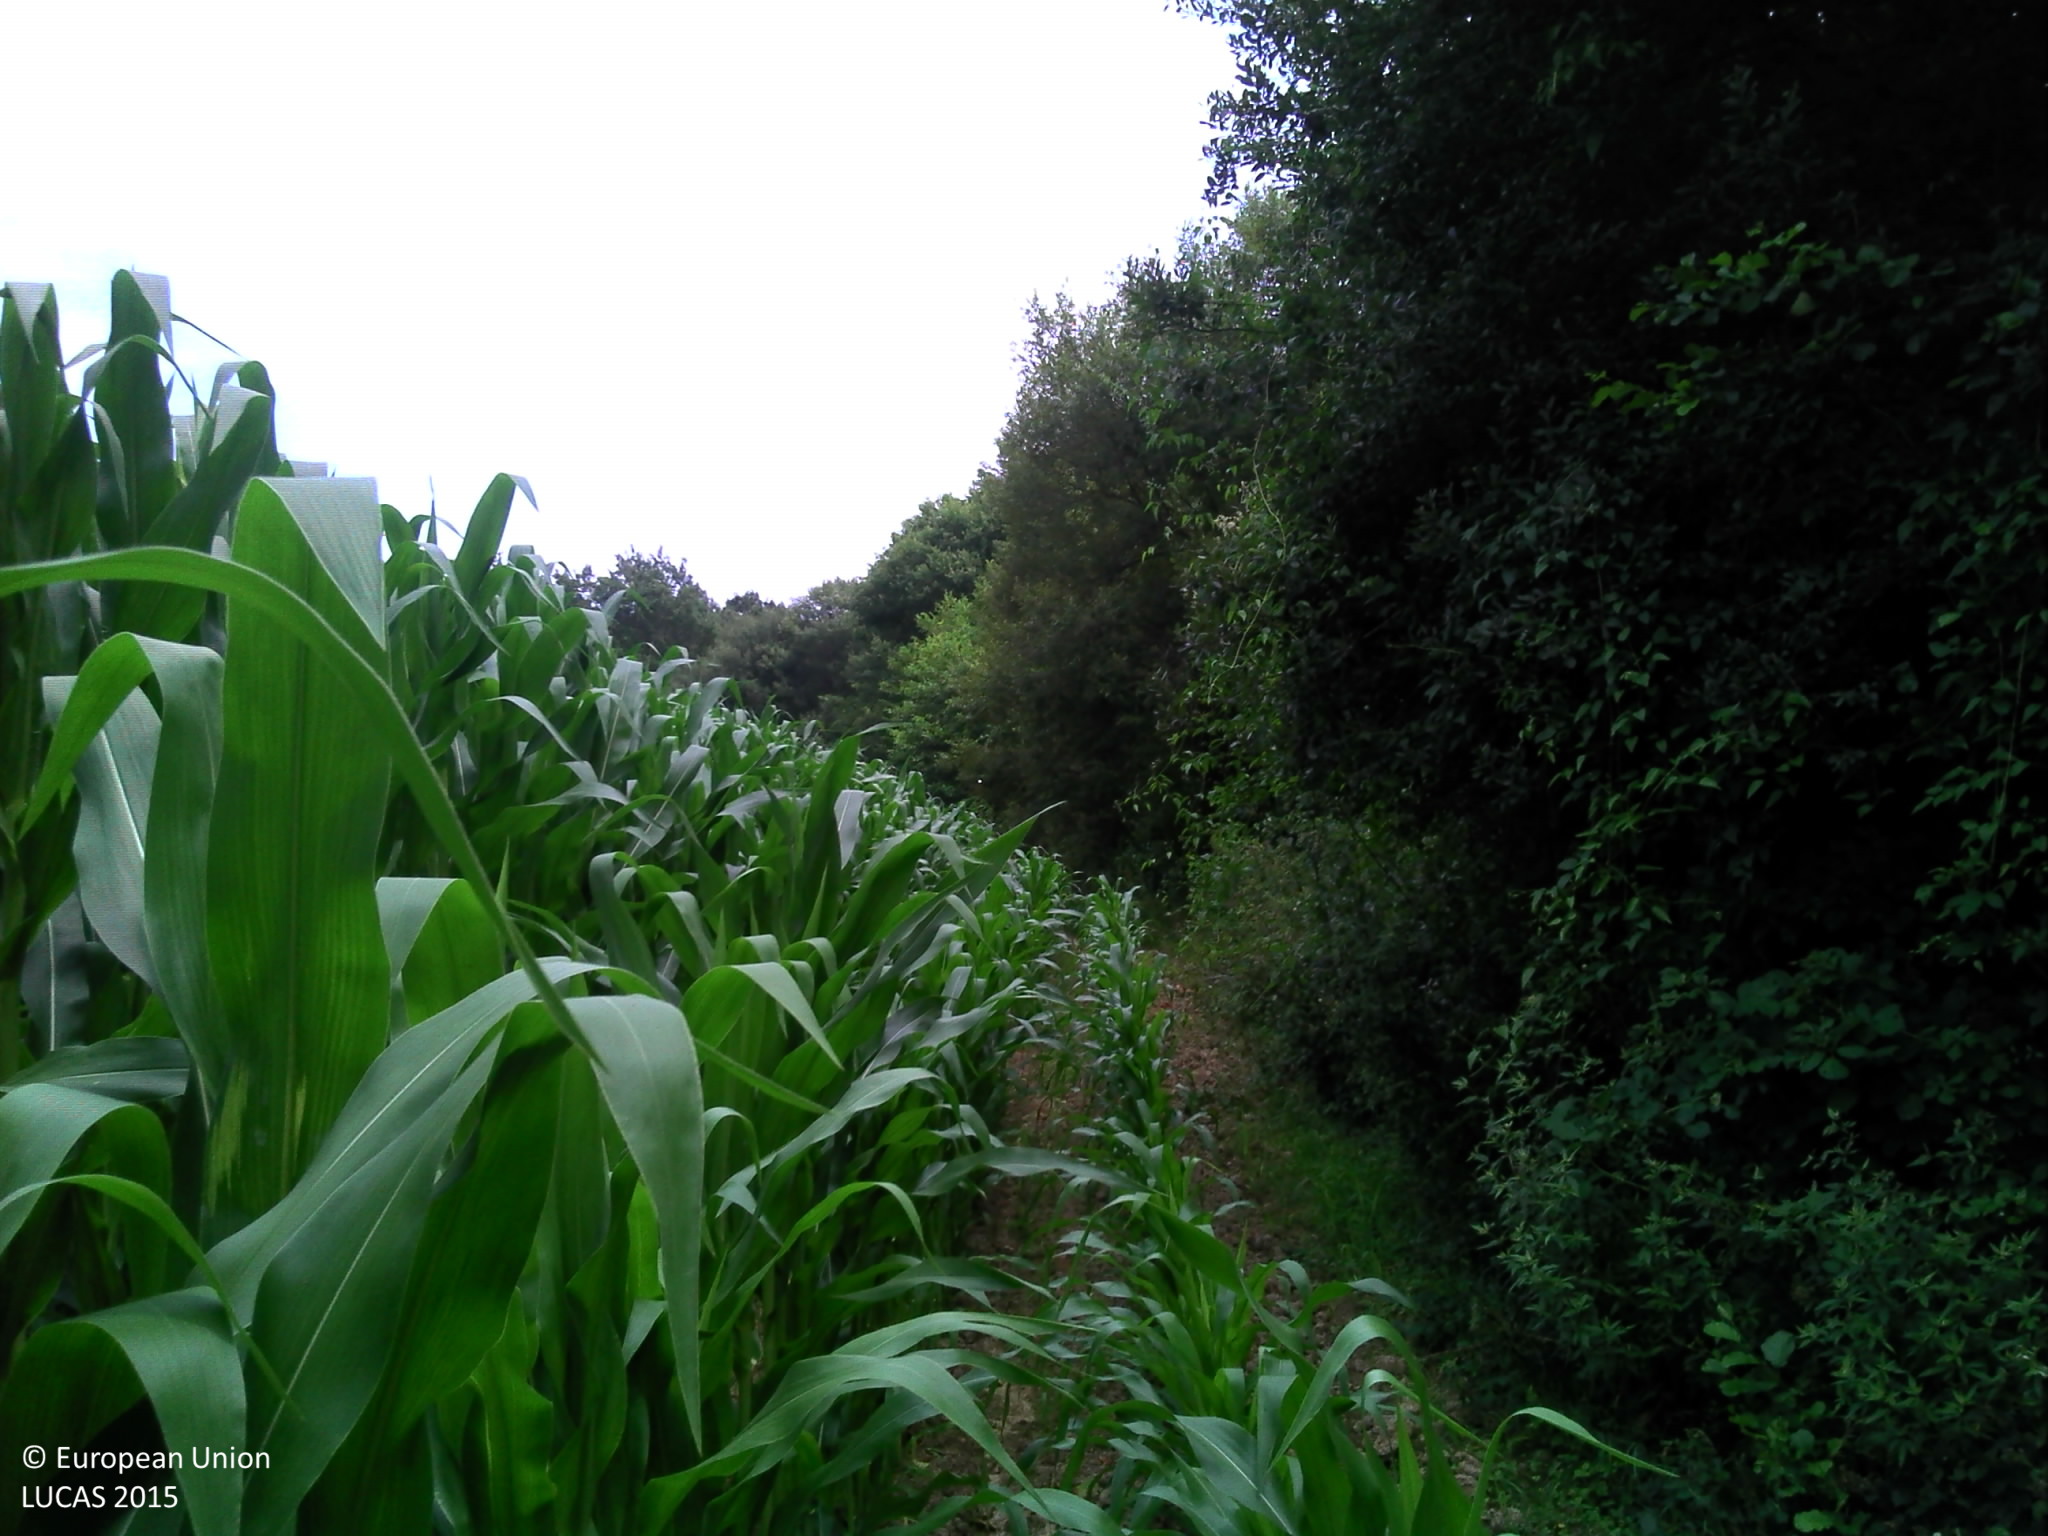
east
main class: Cropland
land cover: Maize
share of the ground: > 75 %
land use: Agriculture (excluding fallow land and kitchen gardens)
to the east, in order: Maize; Tracks; Broadleaved woodland
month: July
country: FR
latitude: 43.5706
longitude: -1.2720
